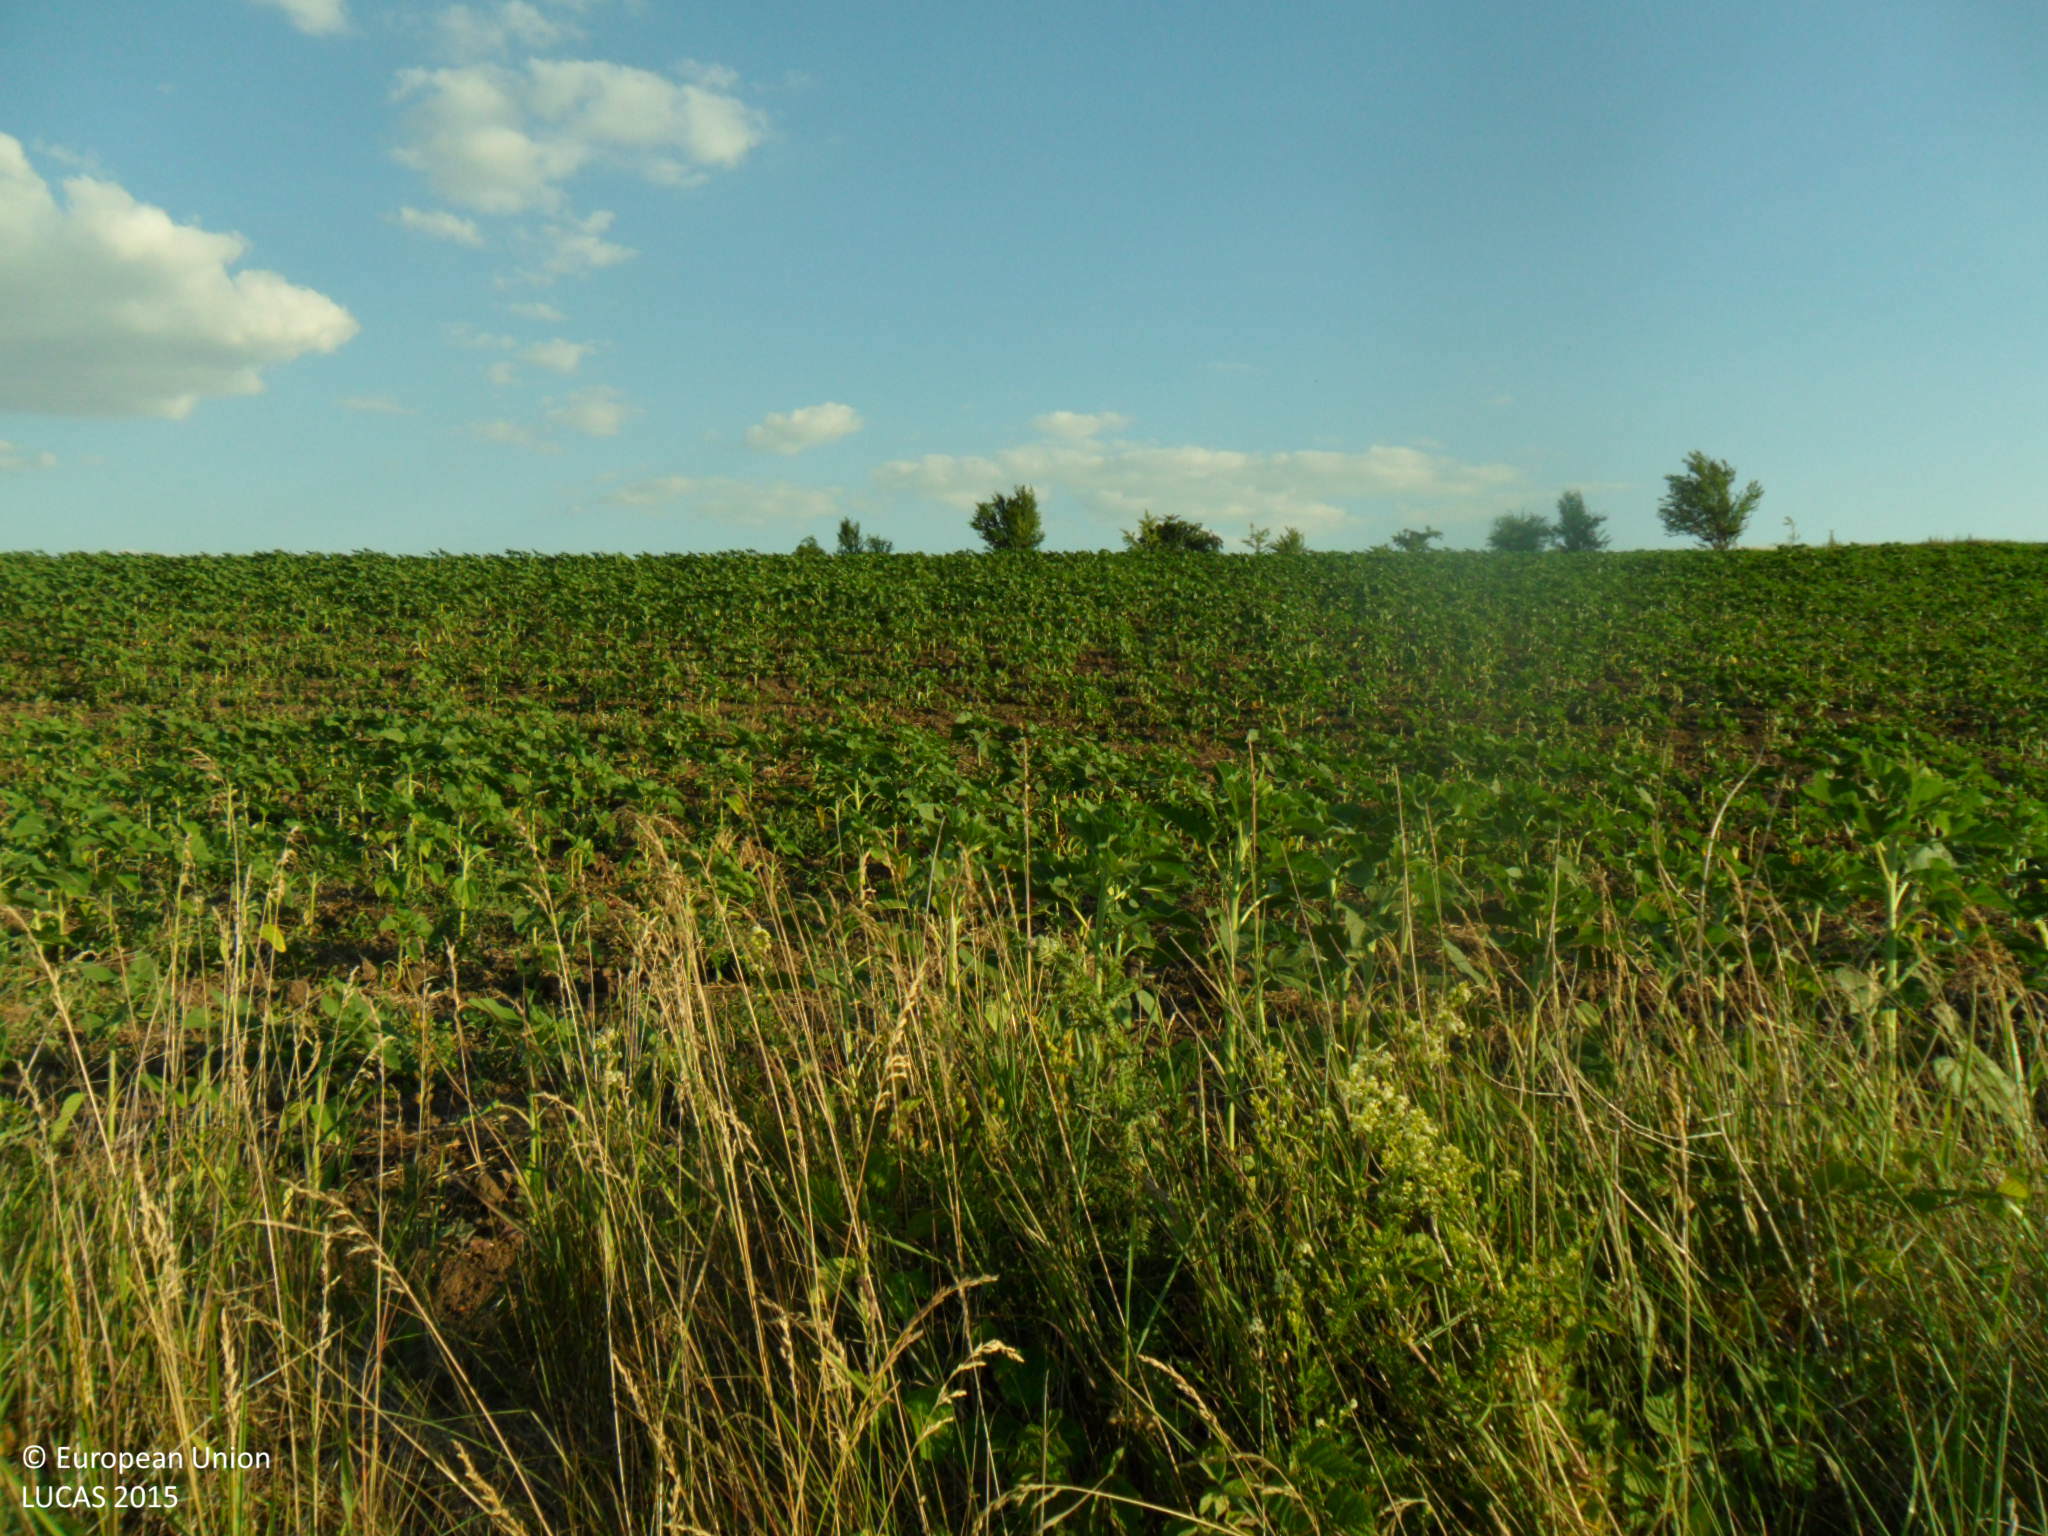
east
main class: Grassland
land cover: Grassland with sparse tree/shrub cover
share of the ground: > 75 %
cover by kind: herbaceous plants 90 %, broadleaved forest trees 5 %, shrubs 5 %
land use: Agriculture (excluding fallow land and kitchen gardens)
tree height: < 5 m
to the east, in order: Grassland with sparse tree/shrub cover; Sunflower; Common wheat
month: June
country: BG
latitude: 43.4773
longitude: 26.8399
